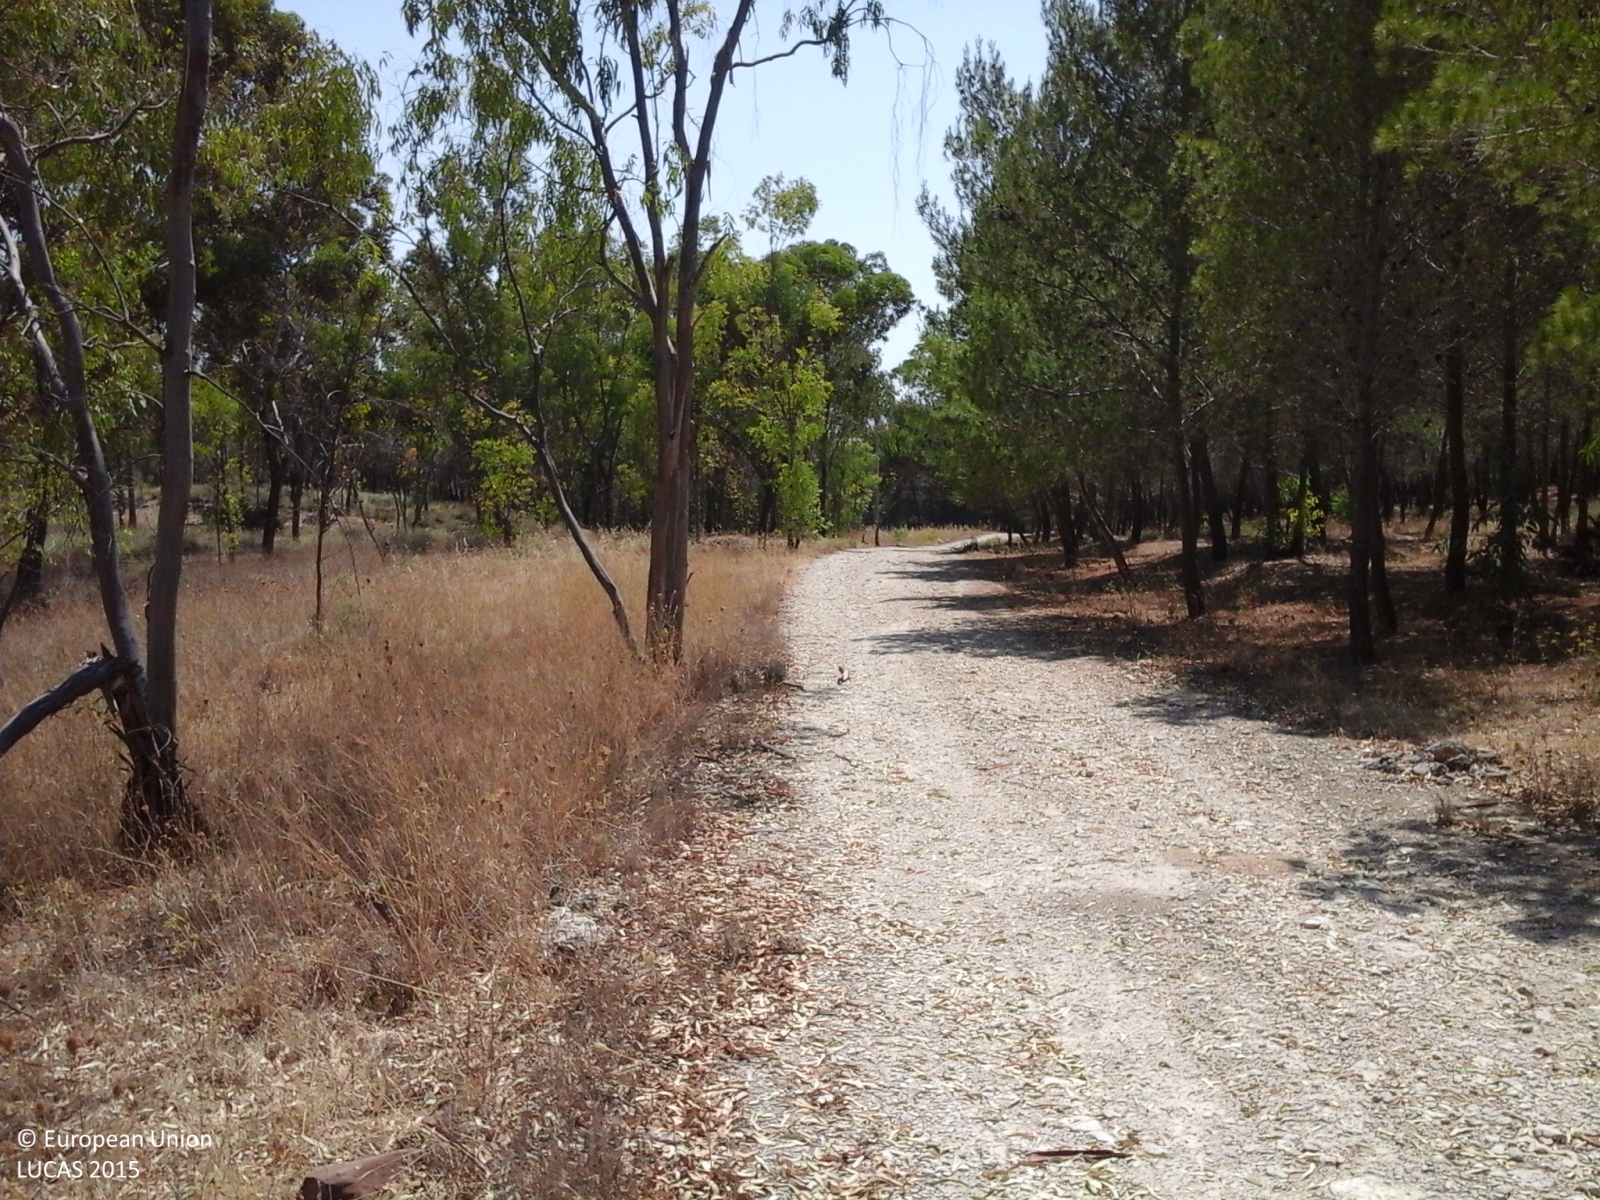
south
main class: Woodland
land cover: Broadleaved woodland
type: exotic forest
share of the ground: > 75 %
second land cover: Grassland without tree/shrub cover
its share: > 75 %
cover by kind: broadleaved forest trees 85 %, shrubs 10 %, herbaceous plants 5 %
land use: Forestry
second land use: Agriculture (excluding fallow land and kitchen gardens)
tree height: > 5 m
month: July
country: IT
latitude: 37.2106
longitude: 14.3721
